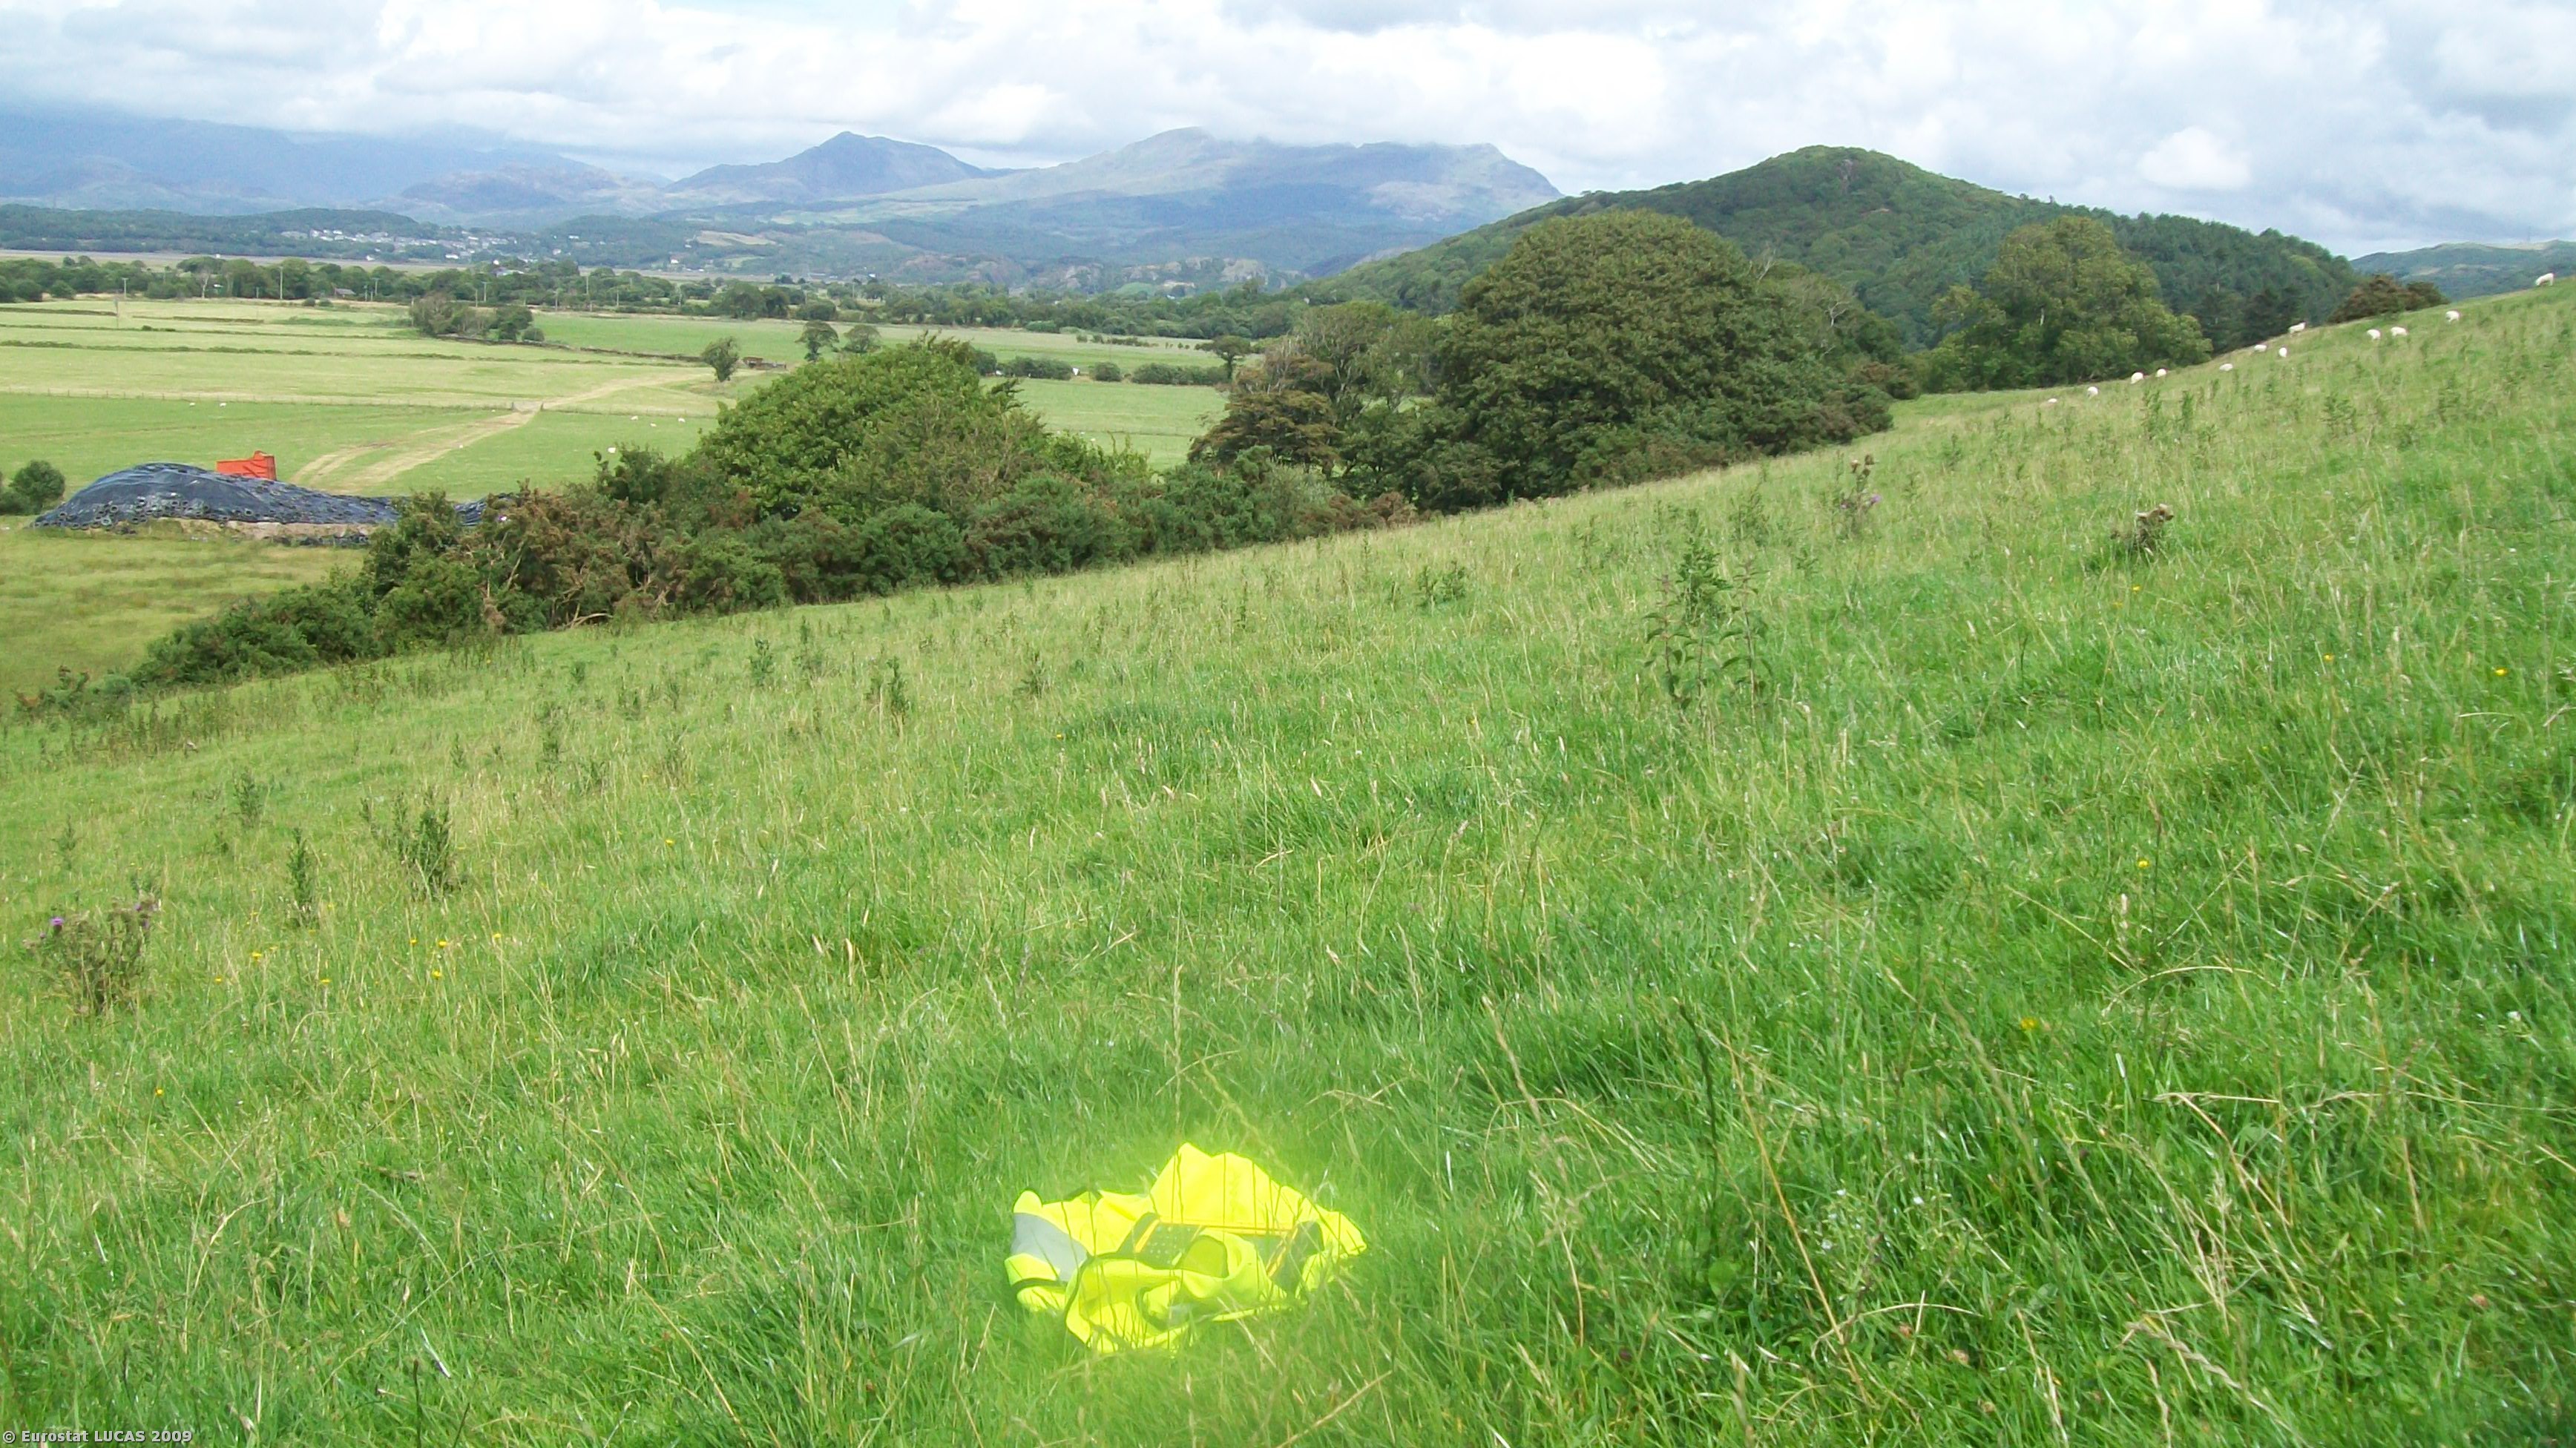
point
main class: Grassland
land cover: Grassland without tree/shrub cover
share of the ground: > 75 %
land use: Agriculture (excluding fallow land and kitchen gardens)
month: August
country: GB
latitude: 52.8842
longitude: -4.0800
